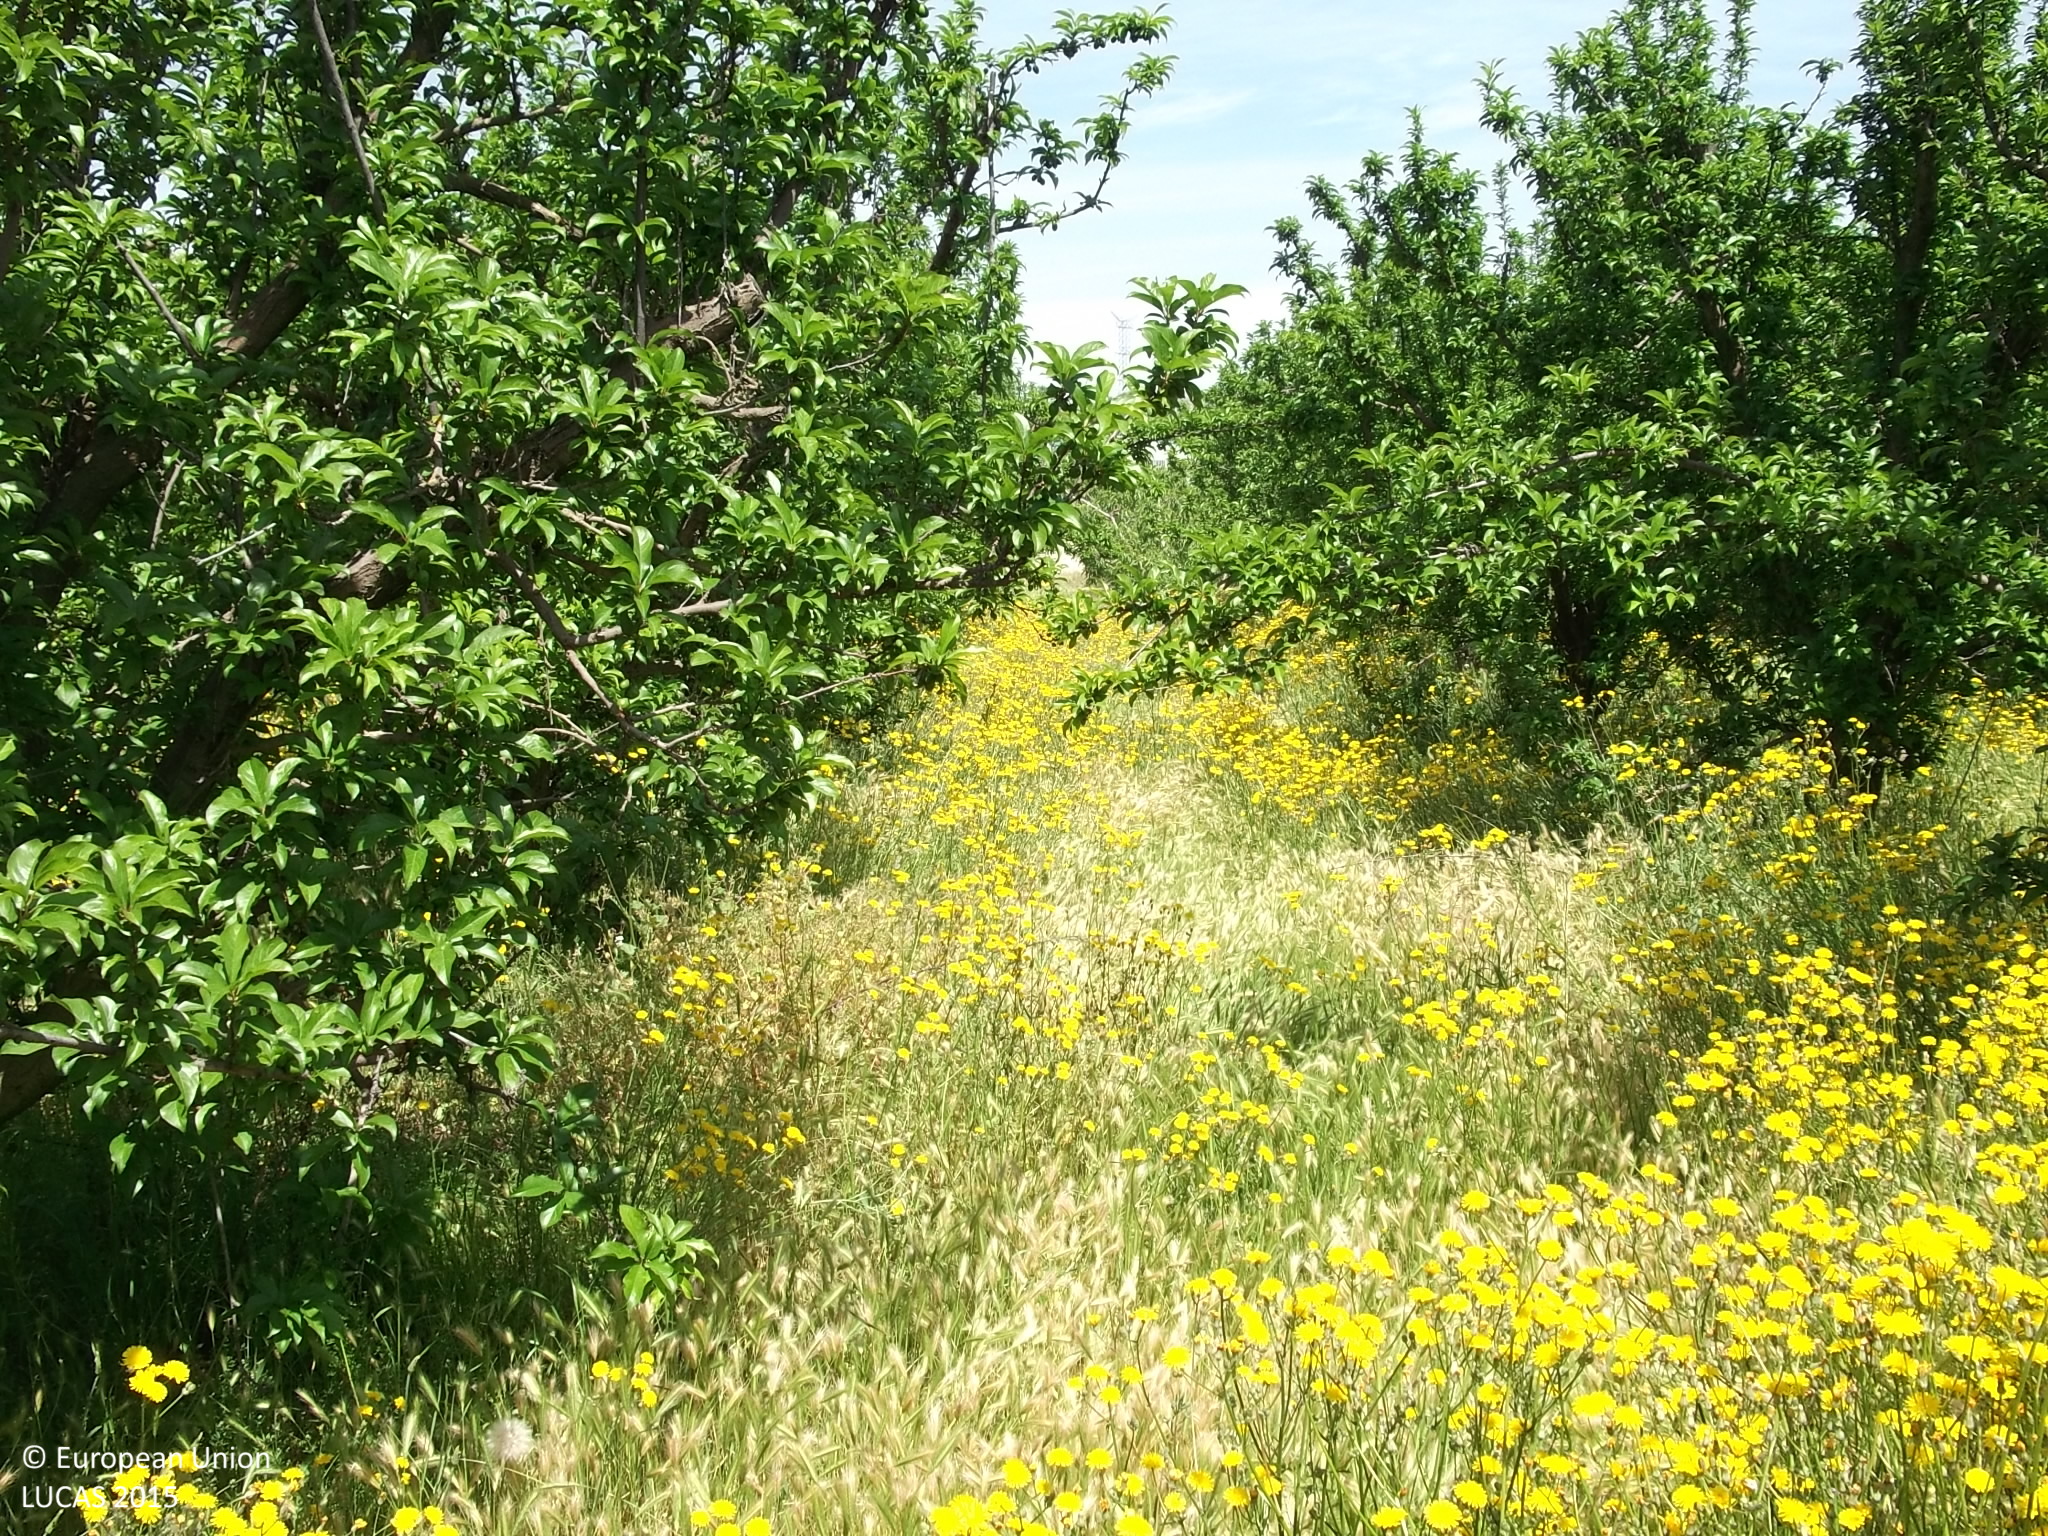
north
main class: Cropland
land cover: Other fruit trees and berries
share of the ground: 25 - 50 %
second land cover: Spontaneously vegetated surfaces
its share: 50 - 75 %
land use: Agriculture (excluding fallow land and kitchen gardens)
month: April
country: ES
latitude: 38.2595
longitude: -1.6124
